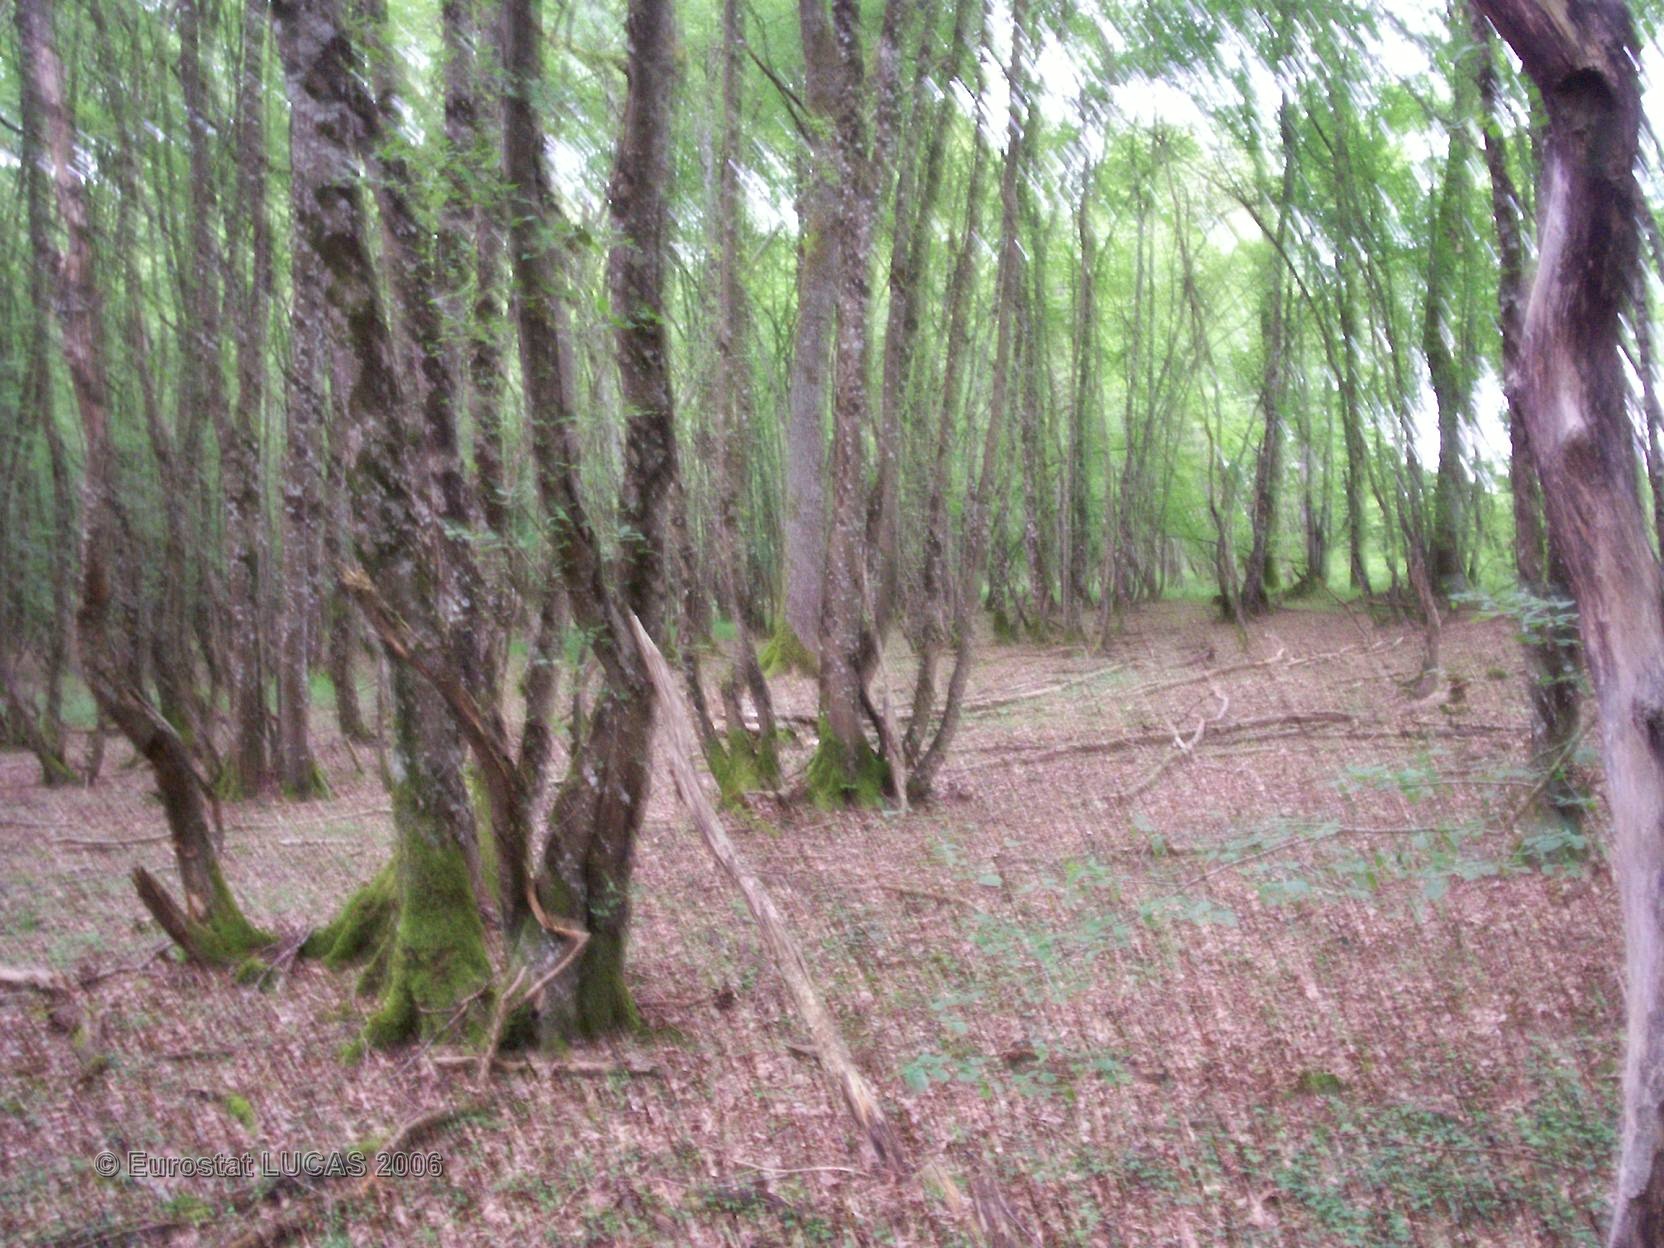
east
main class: Woodland
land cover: Broadleaved forest
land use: Forestry
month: May
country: FR
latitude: 46.8827
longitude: 3.0281
